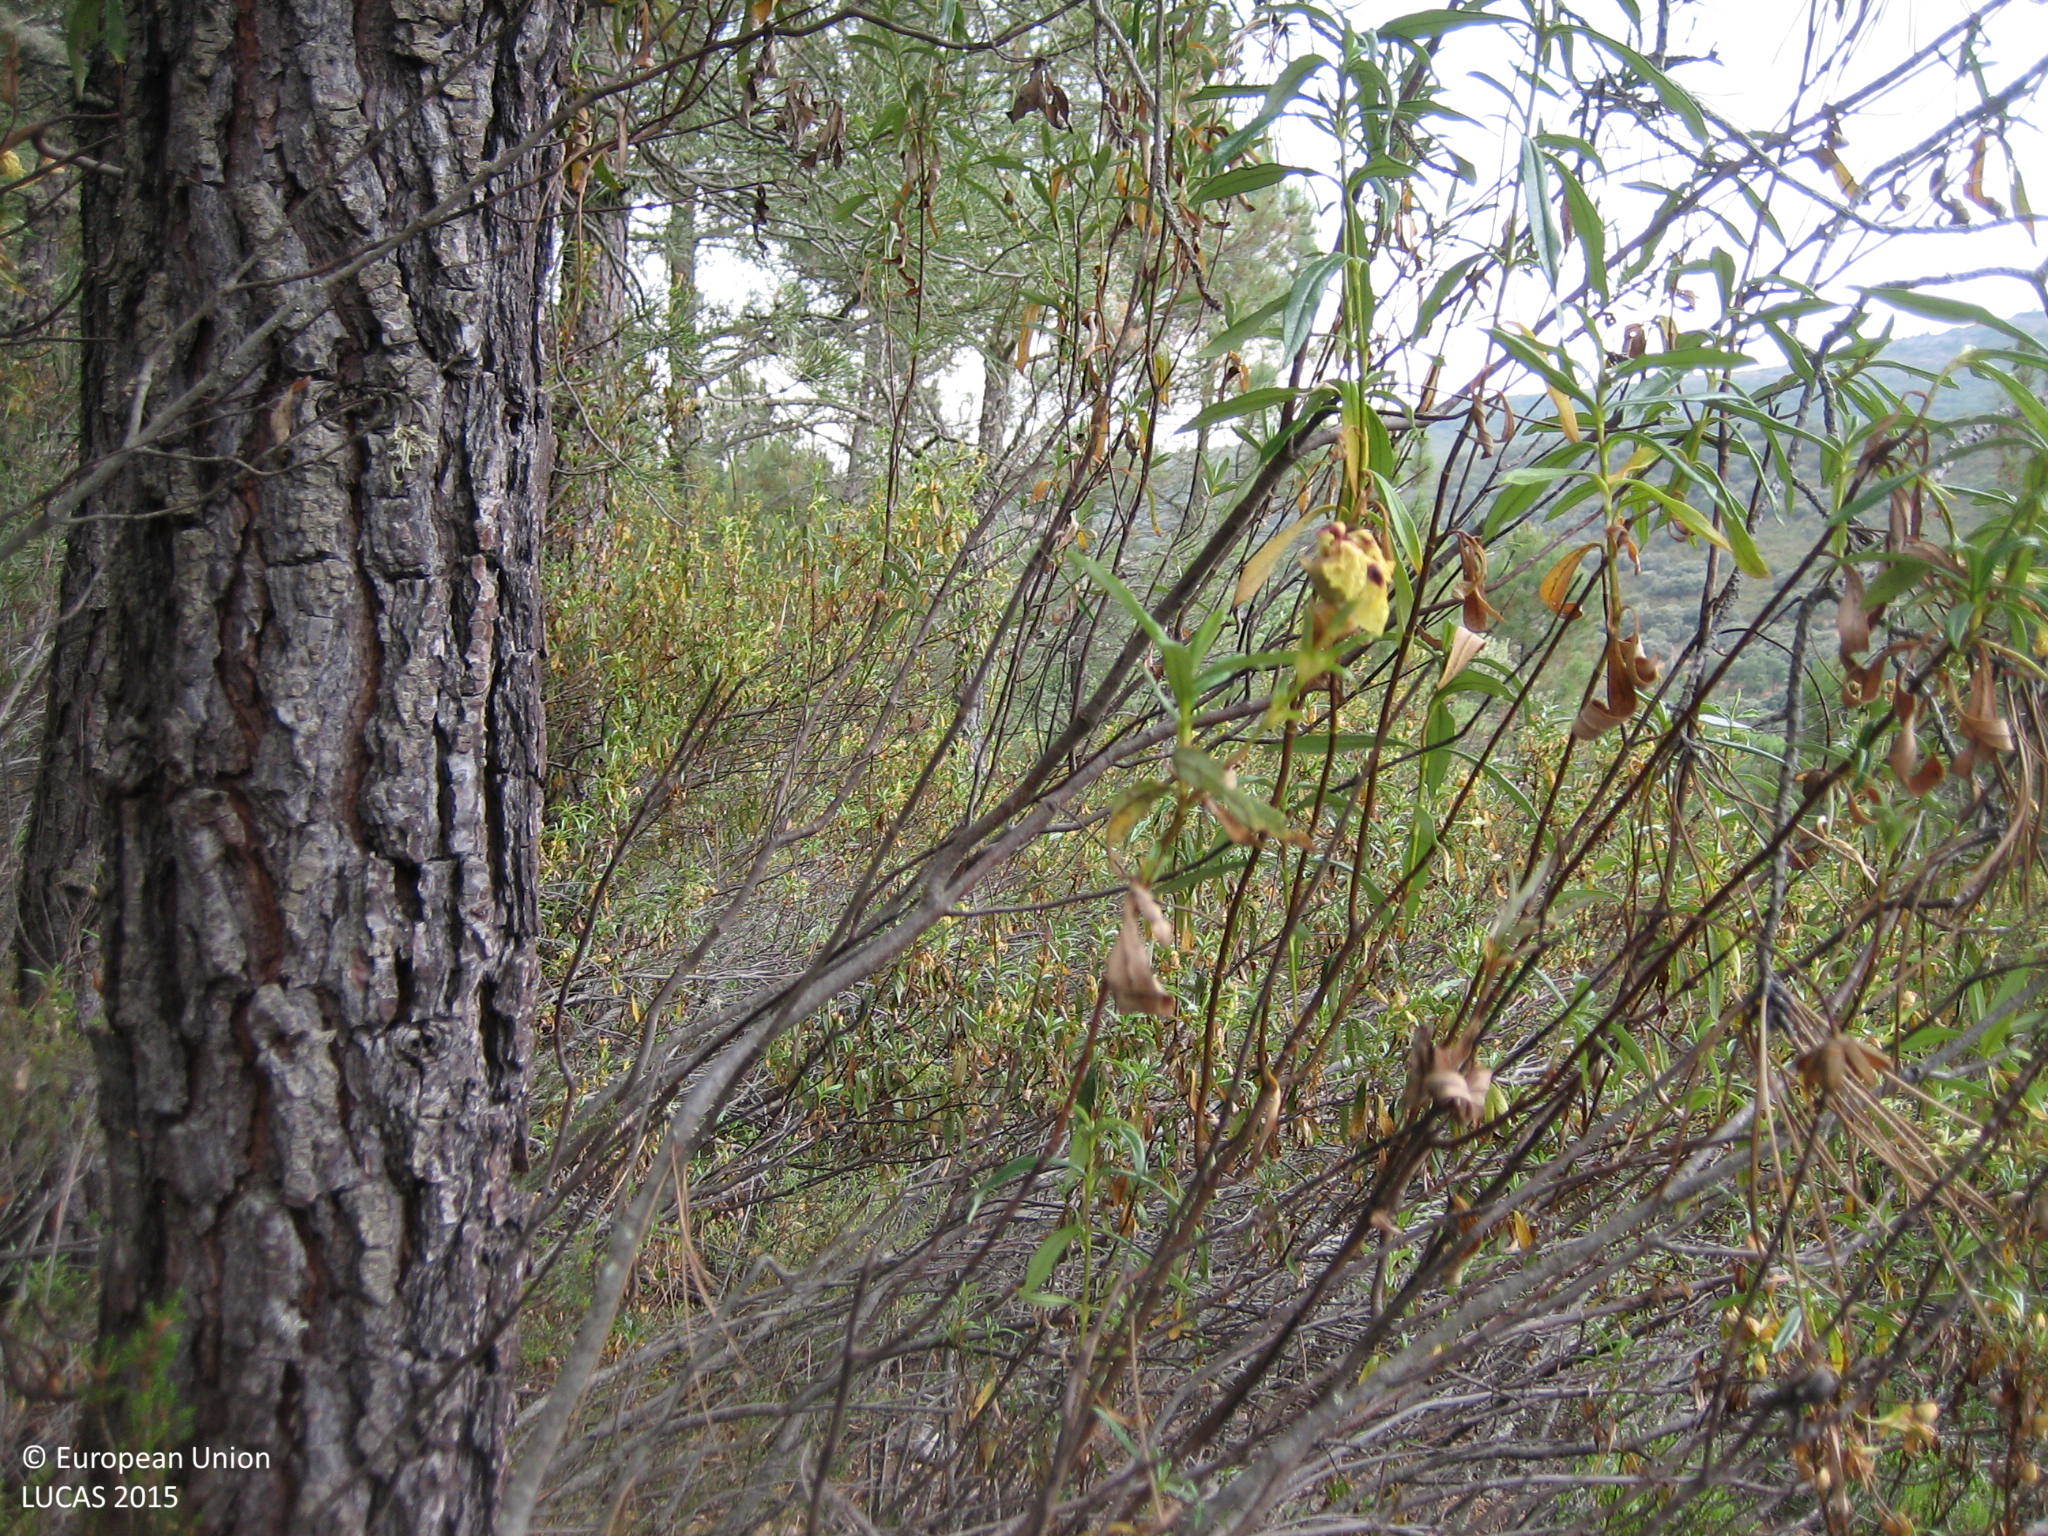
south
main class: Shrubland
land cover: Shrubland with sparse tree cover
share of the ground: > 75 %
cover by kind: shrubs 95 %, broadleaved forest trees 5 %
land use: Semi-natural and natural areas not in use
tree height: < 5 m
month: June
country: ES
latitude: 39.0575
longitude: -4.4856
